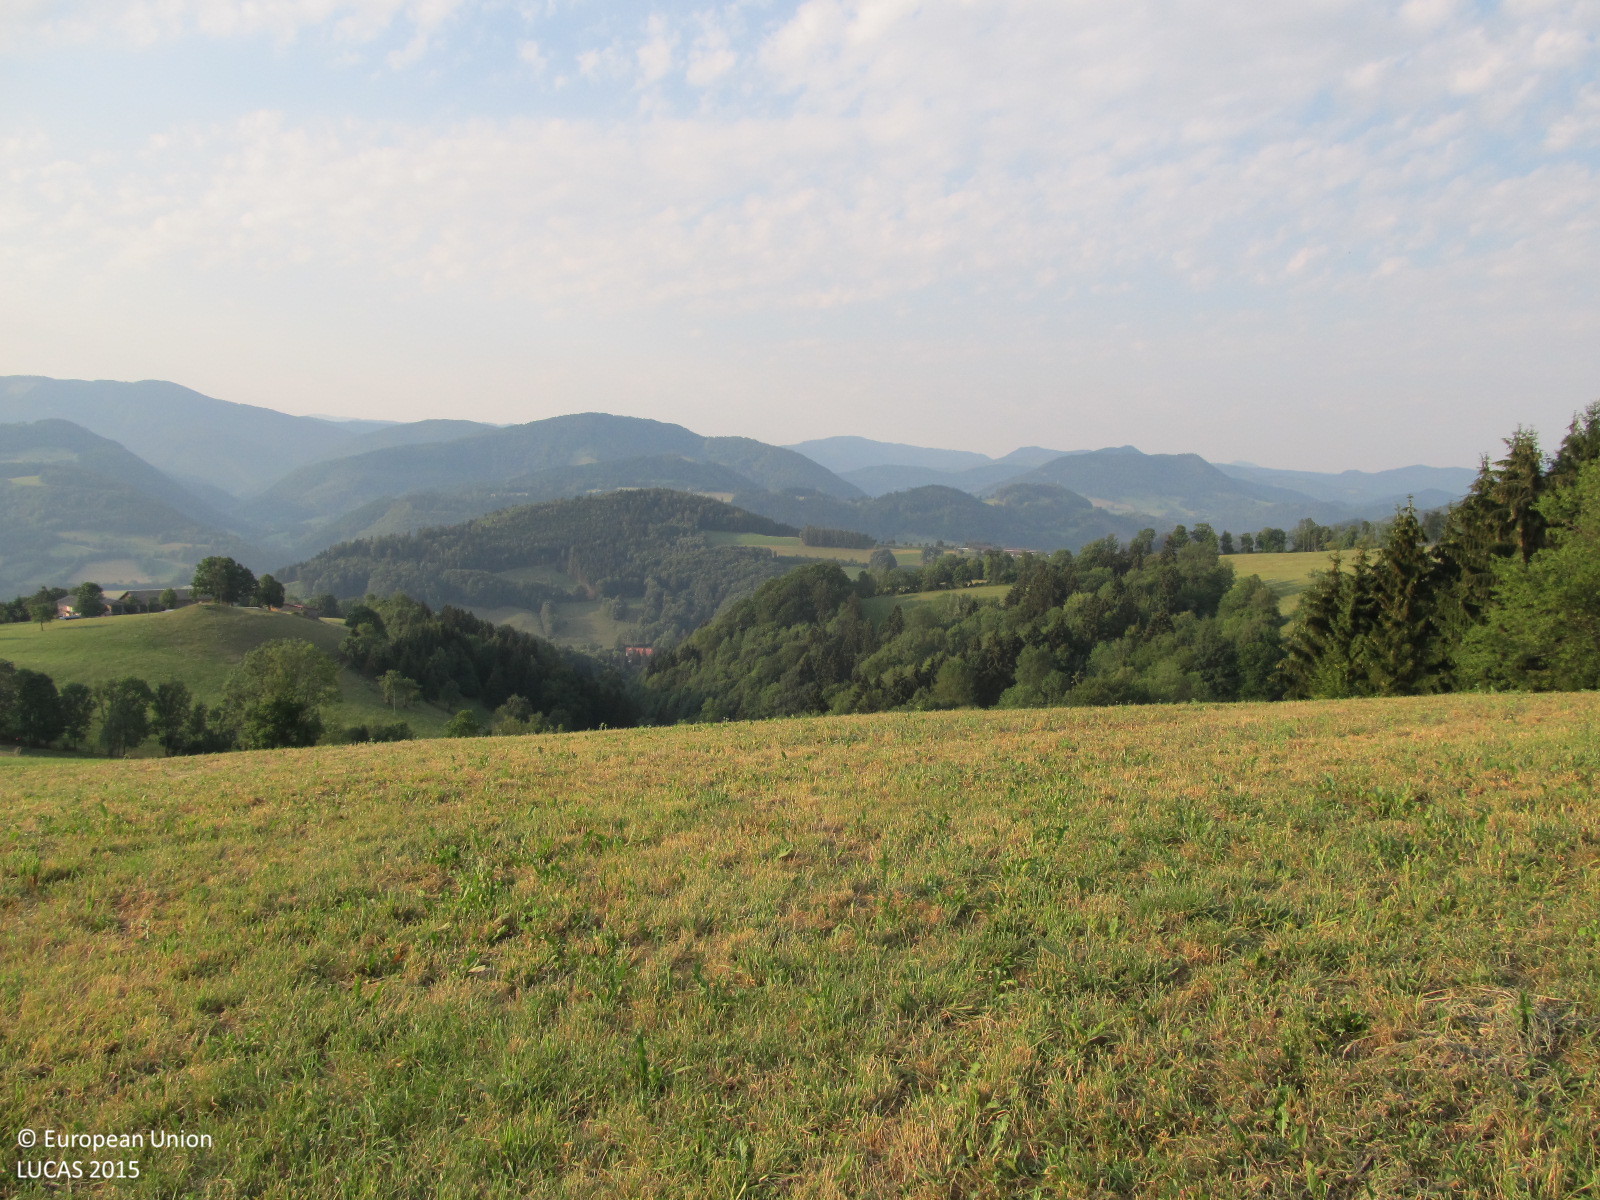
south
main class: Grassland
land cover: Grassland without tree/shrub cover
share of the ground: > 75 %
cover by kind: herbaceous plants 100 %
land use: Agriculture (excluding fallow land and kitchen gardens)
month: August
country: AT
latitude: 48.0381
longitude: 15.3801
